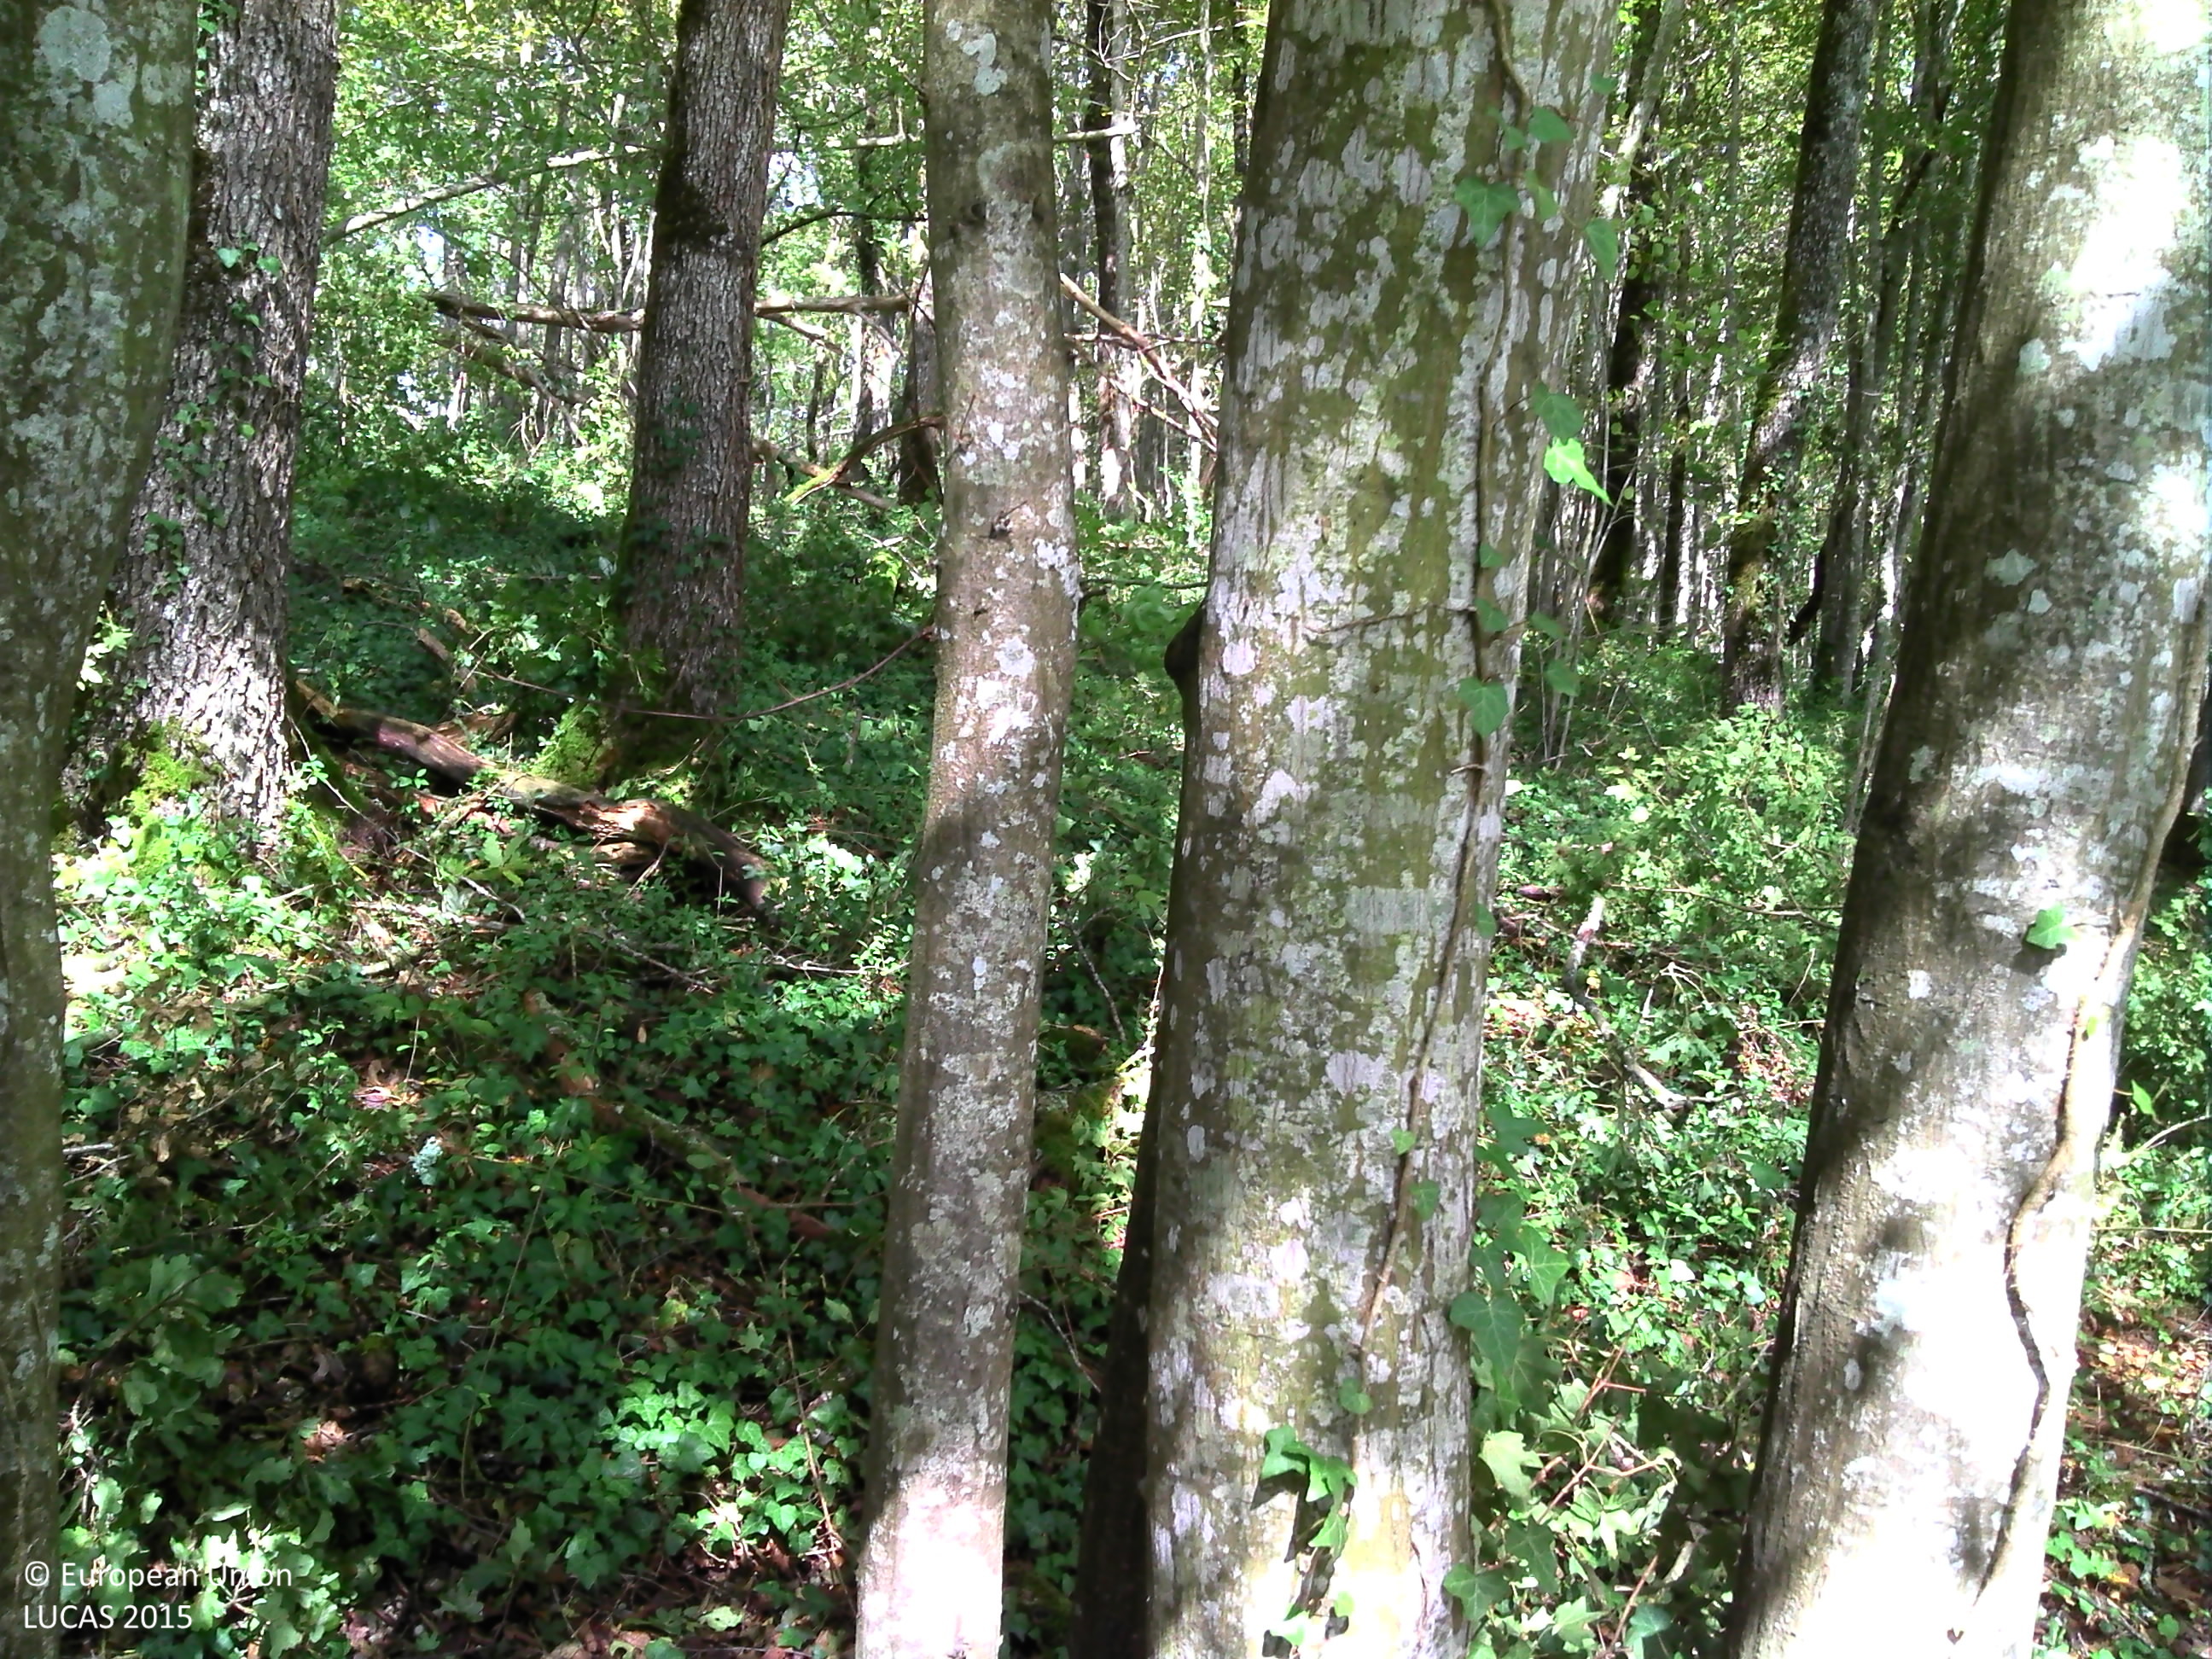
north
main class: Woodland
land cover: Broadleaved woodland
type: mesophytic deciduous forest
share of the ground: > 75 %
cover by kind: broadleaved forest trees 80 %, herbaceous plants 10 %, shrubs 5 %, lichens and mosses 5 %
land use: Forestry
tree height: > 5 m
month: September
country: FR
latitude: 48.2919
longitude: 4.6469
